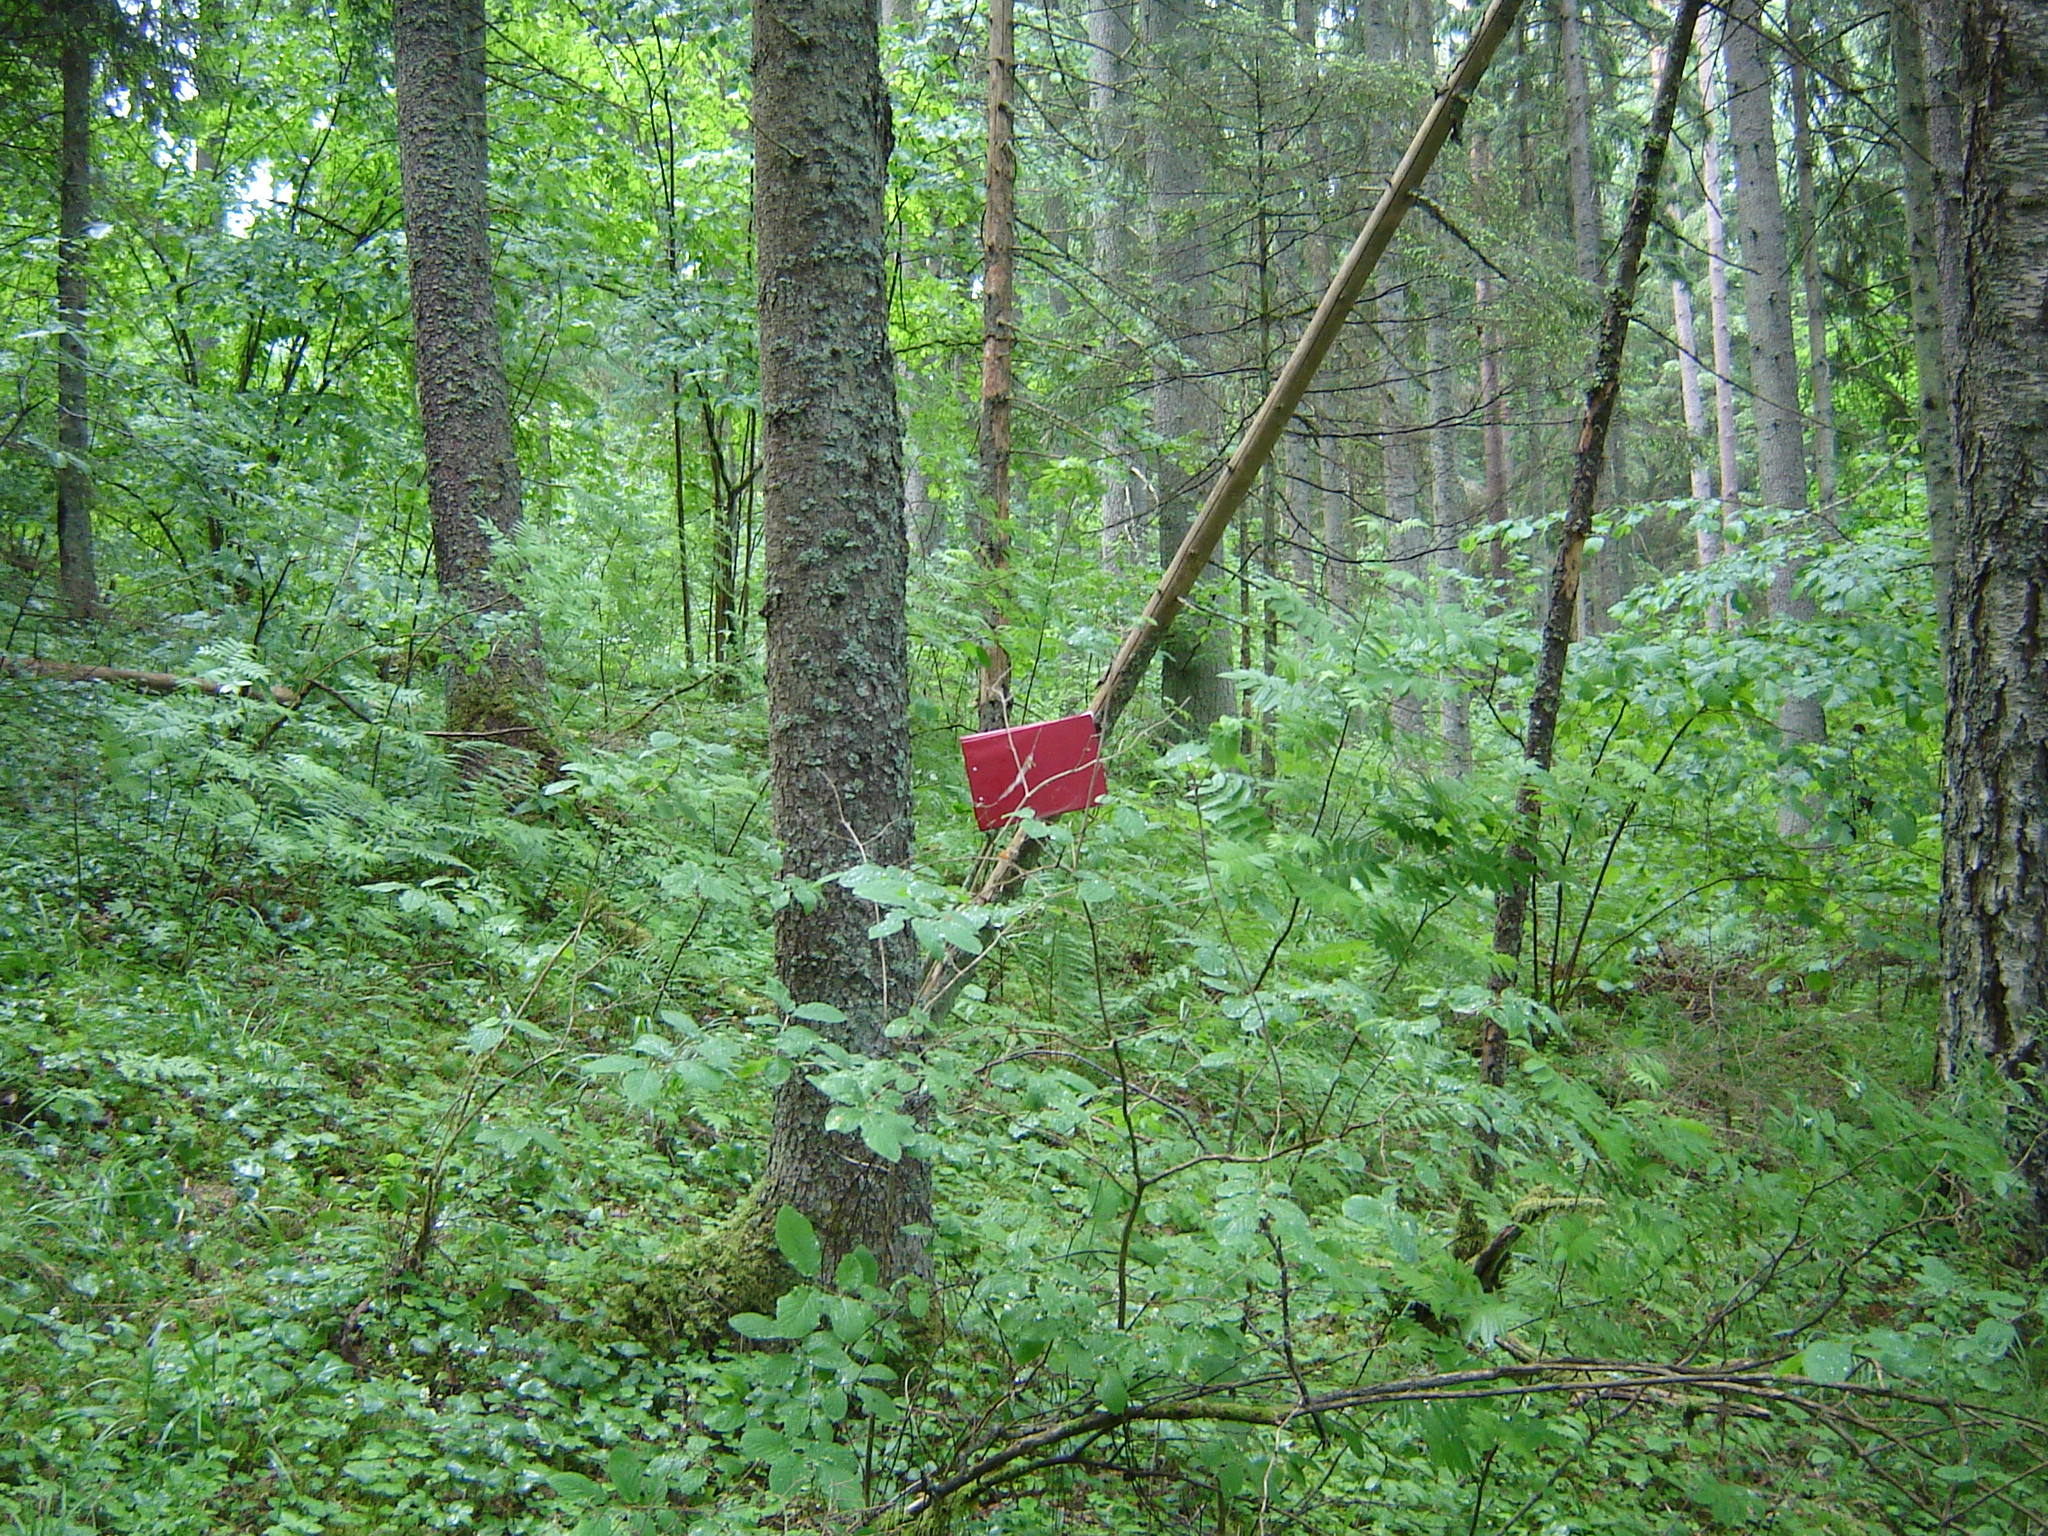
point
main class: Woodland
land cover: Spruce dominated coniferous woodland
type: hemiboreal forest and nemoral coniferous forest and mixed broadleaved-coniferous forest
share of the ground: > 75 %
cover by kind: coniferous forest trees 90 %, broadleaved forest trees 10 %
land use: Forestry
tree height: > 5 m
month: June
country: LT
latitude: 55.6594
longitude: 25.2006
